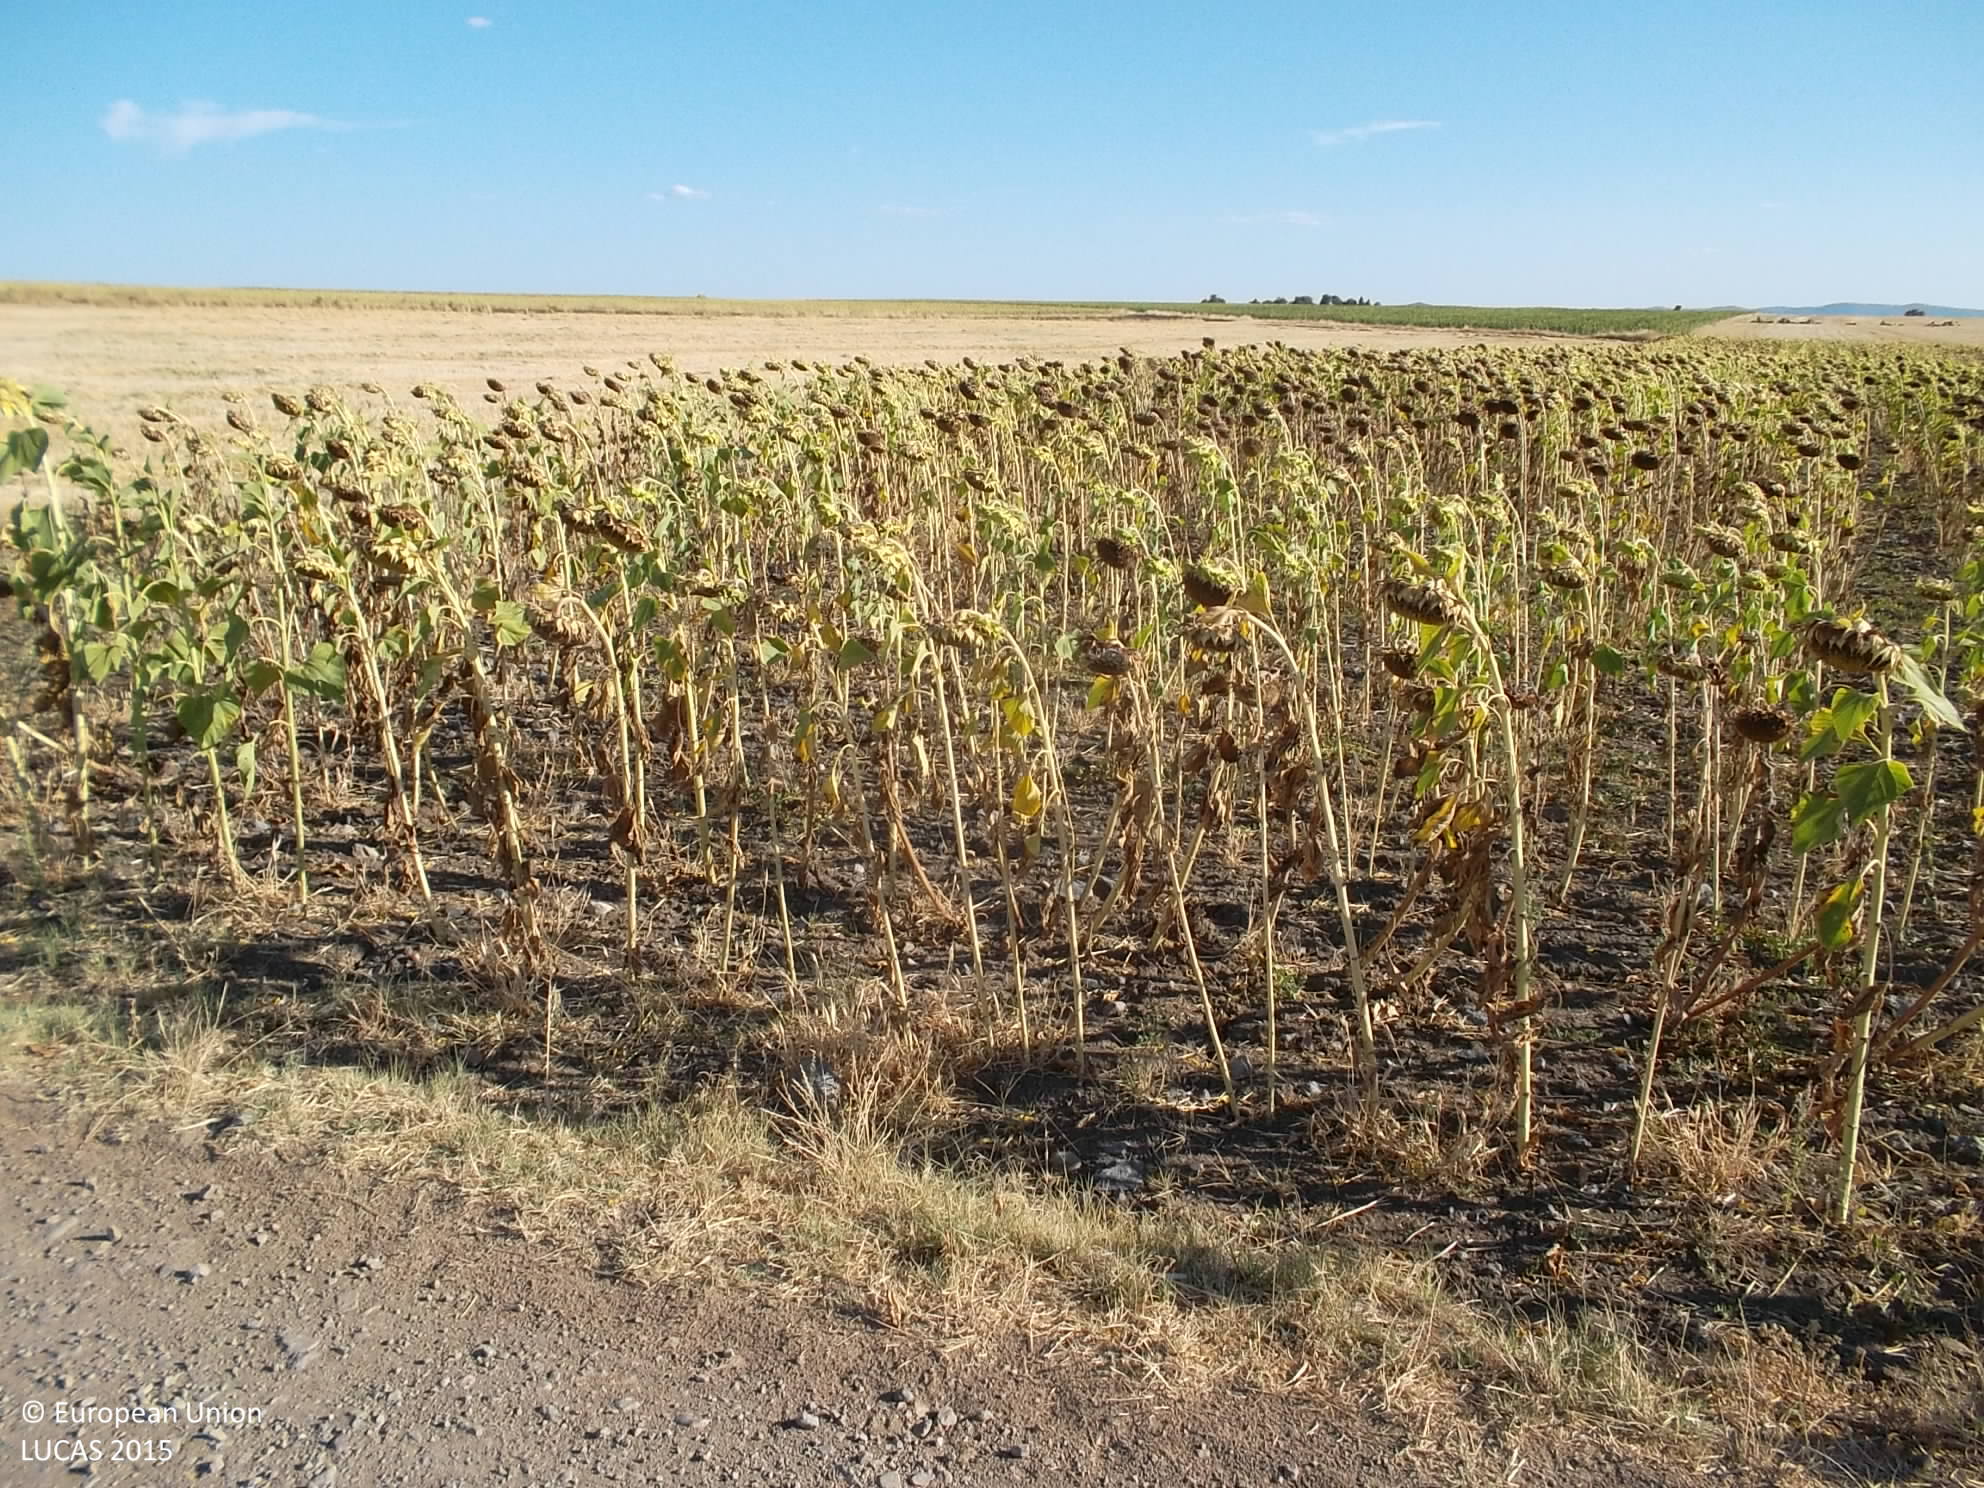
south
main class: Artificial land
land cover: Non built-up linear features
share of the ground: > 75 %
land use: Road transport
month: July
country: ES
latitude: 38.3111
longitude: -5.7152
